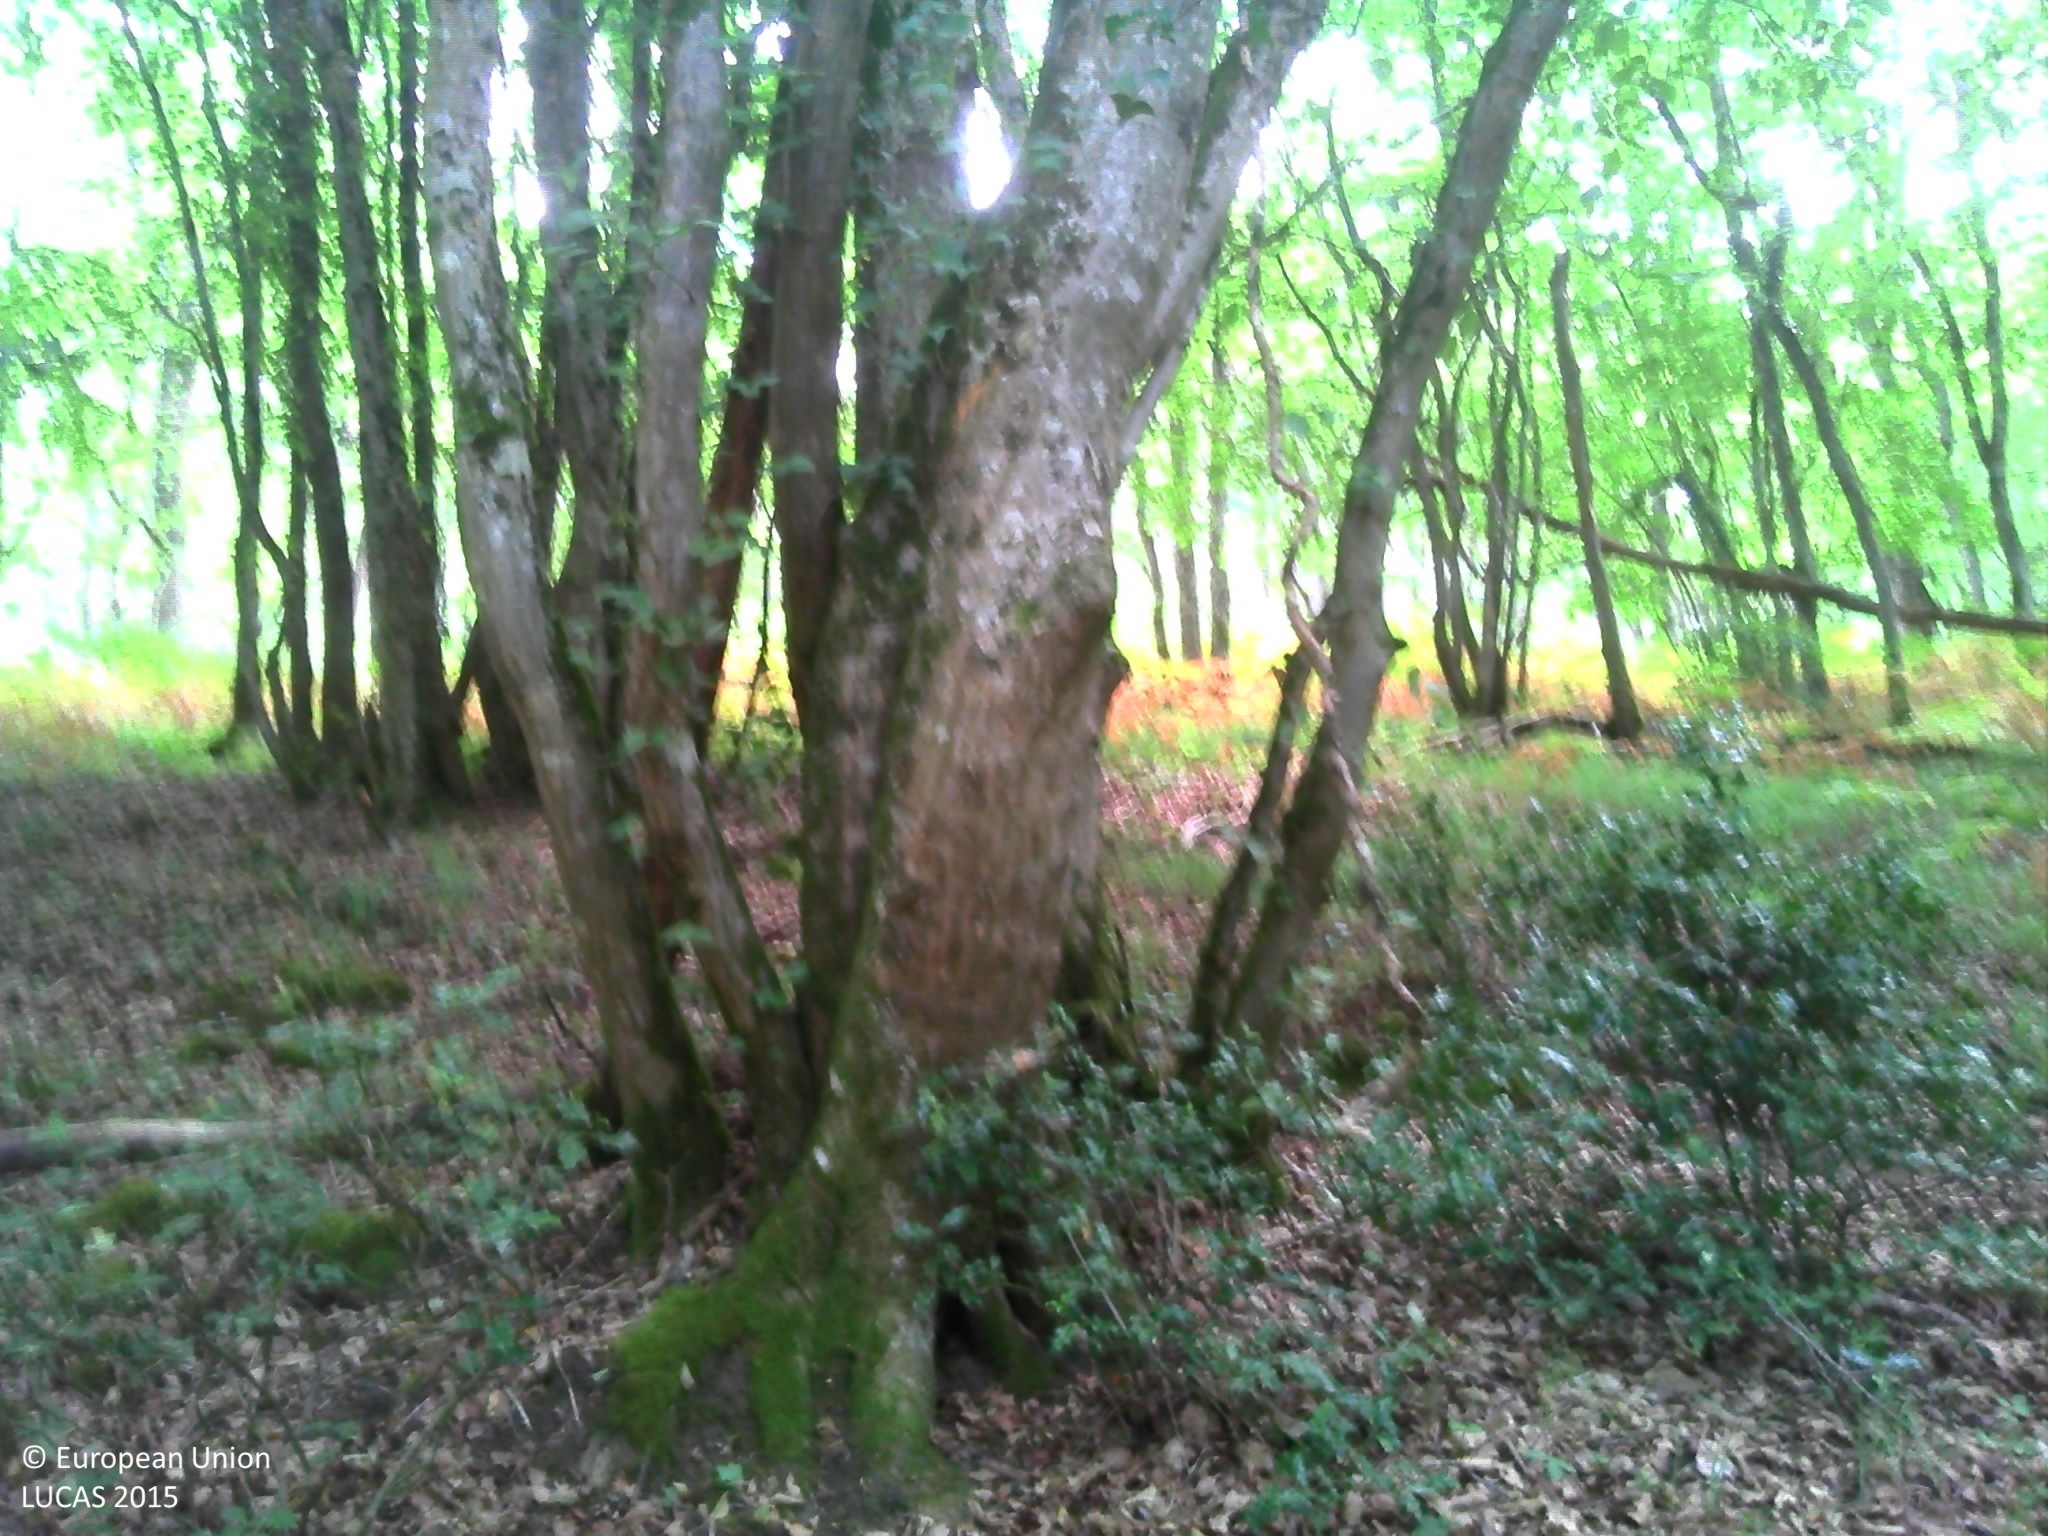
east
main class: Woodland
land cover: Broadleaved woodland
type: mesophytic deciduous forest
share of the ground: > 75 %
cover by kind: broadleaved forest trees 85 %, shrubs 5 %, herbaceous plants 5 %, lichens and mosses 5 %
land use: Forestry
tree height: > 5 m
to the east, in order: Broadleaved woodland
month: July
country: FR
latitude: 46.8970
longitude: 0.8083
